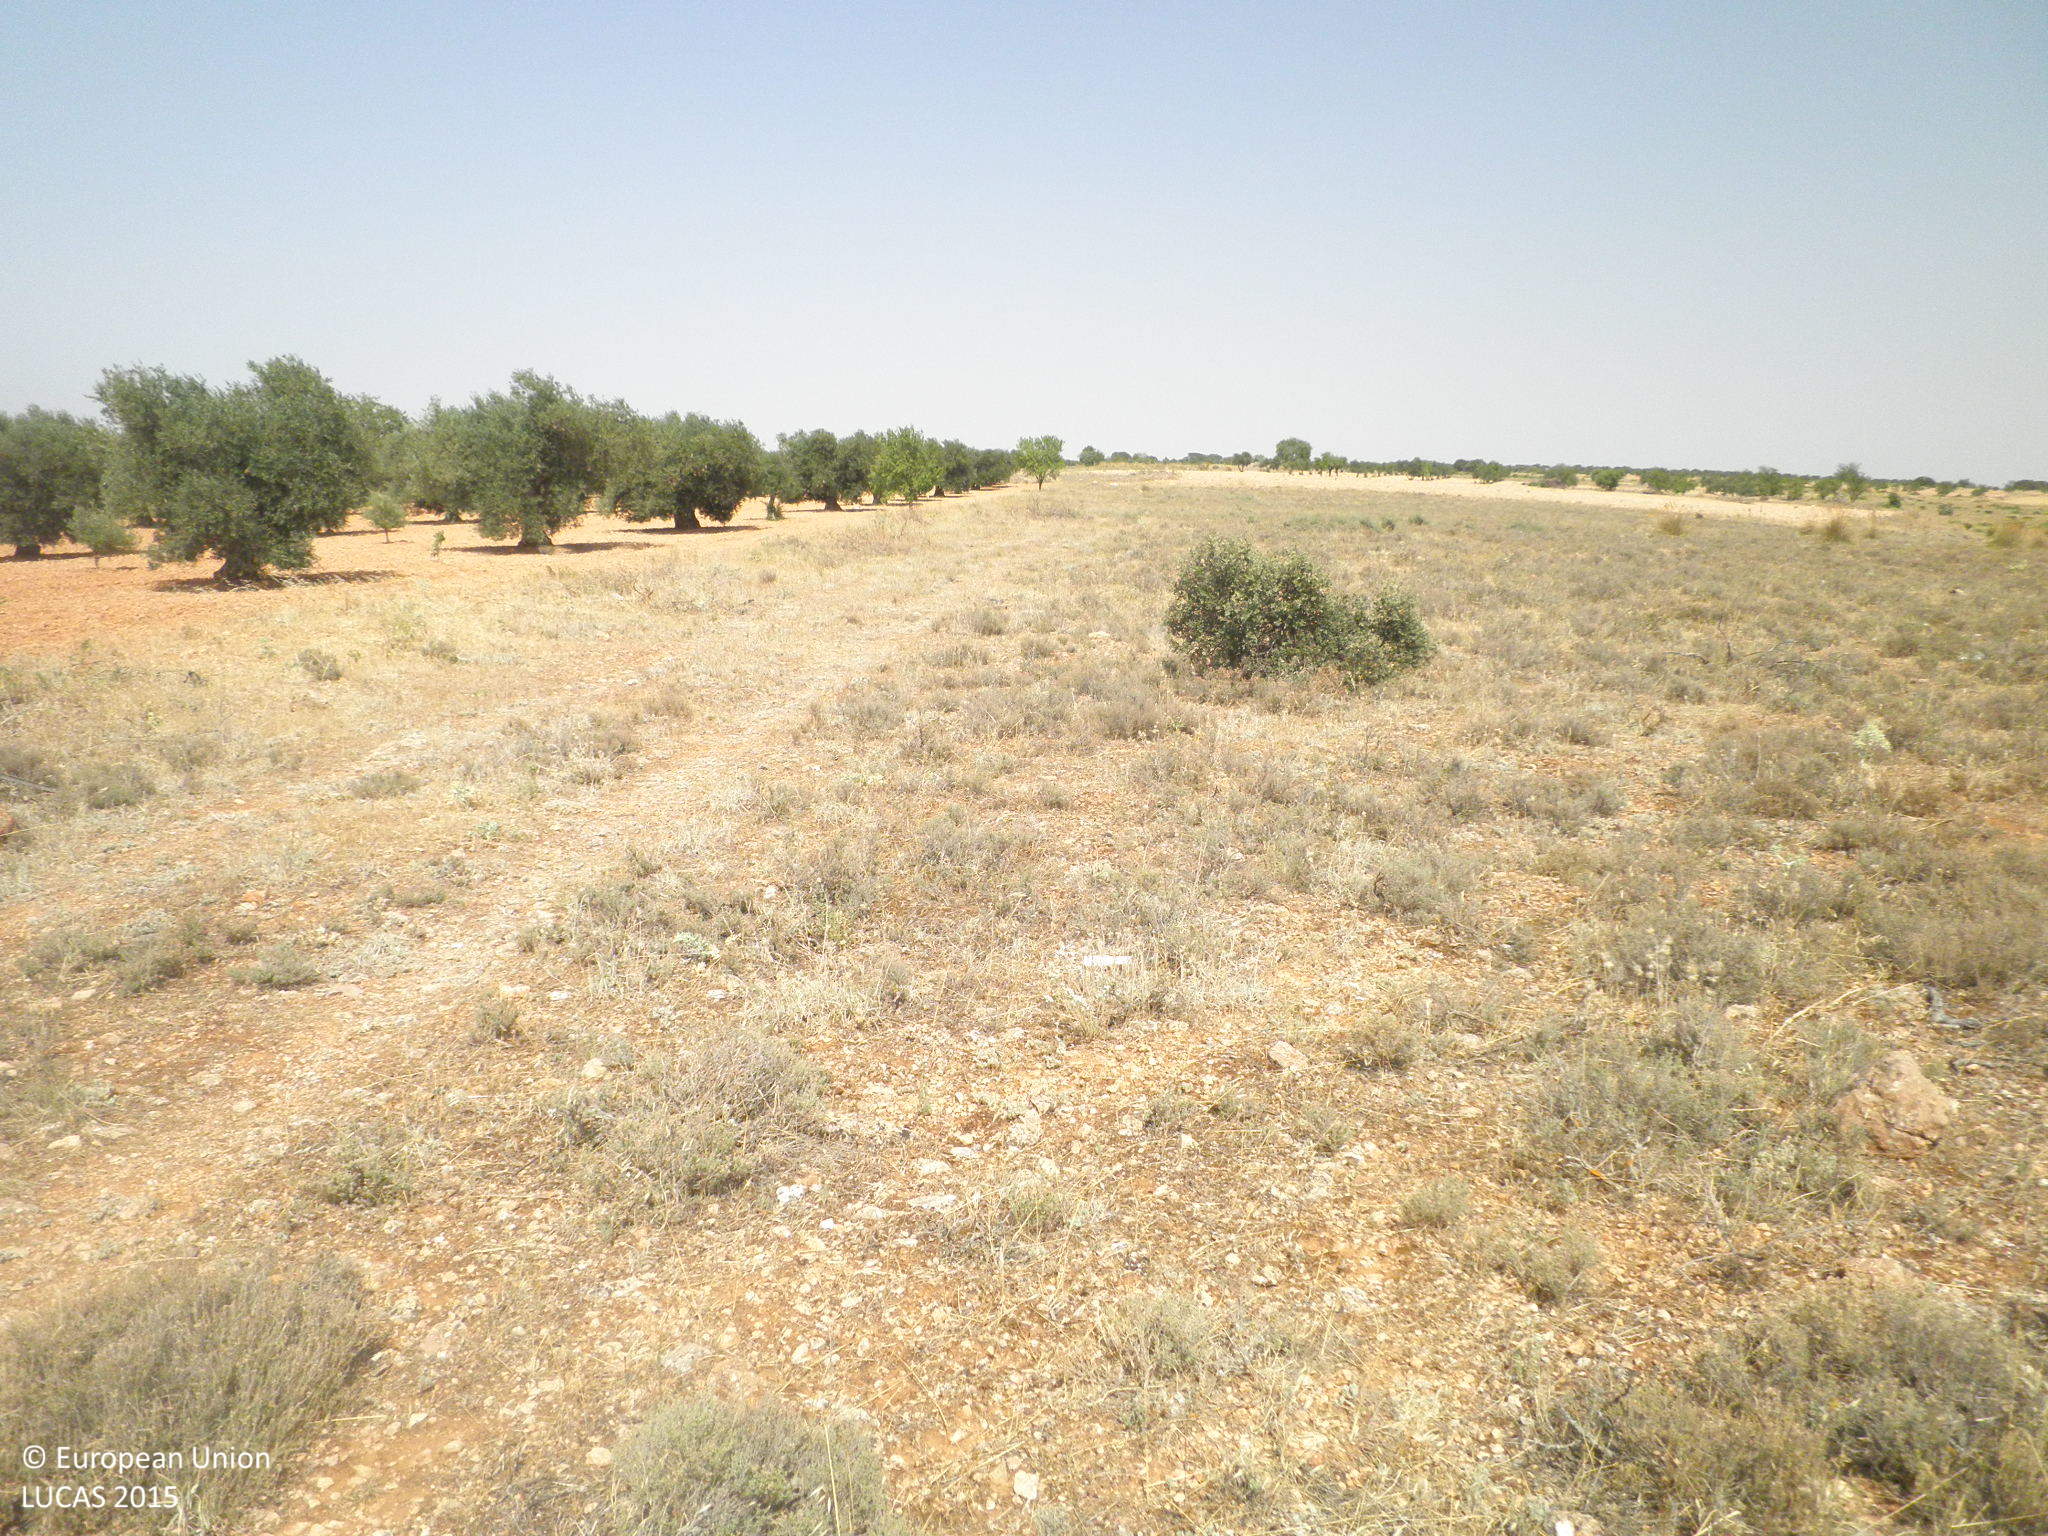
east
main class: Shrubland
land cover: Shrubland without tree cover
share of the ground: 25 - 50 %
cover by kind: unconsolidated bare surface 50 %, shrubs 30 %, herbaceous plants 20 %
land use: Abandoned areas
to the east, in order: Shrubland without tree cover; Other bare soil; Shrubland without tree cover
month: July
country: ES
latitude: 39.4636
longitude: -2.6471
